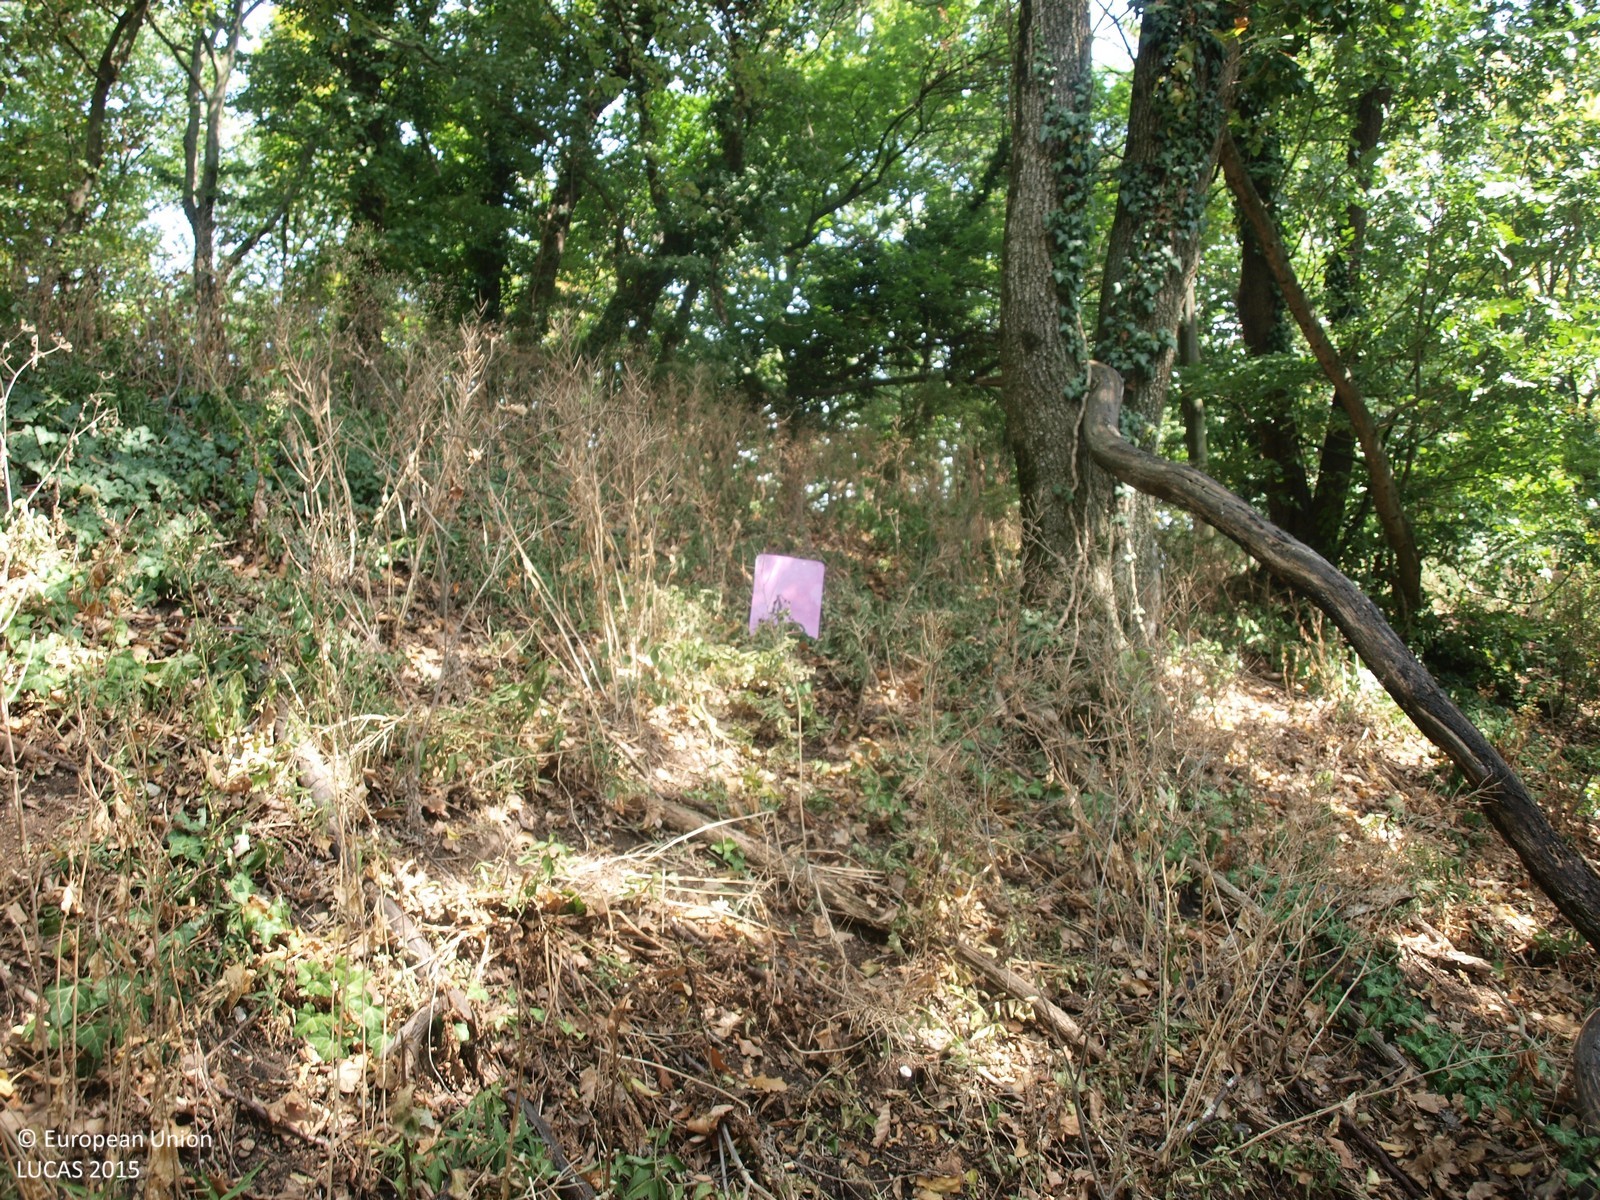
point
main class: Woodland
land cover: Broadleaved woodland
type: mesophytic deciduous forest
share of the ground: > 75 %
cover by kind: broadleaved forest trees 100 %
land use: Forestry
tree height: > 5 m
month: August
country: HR
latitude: 46.1246
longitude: 16.3799
